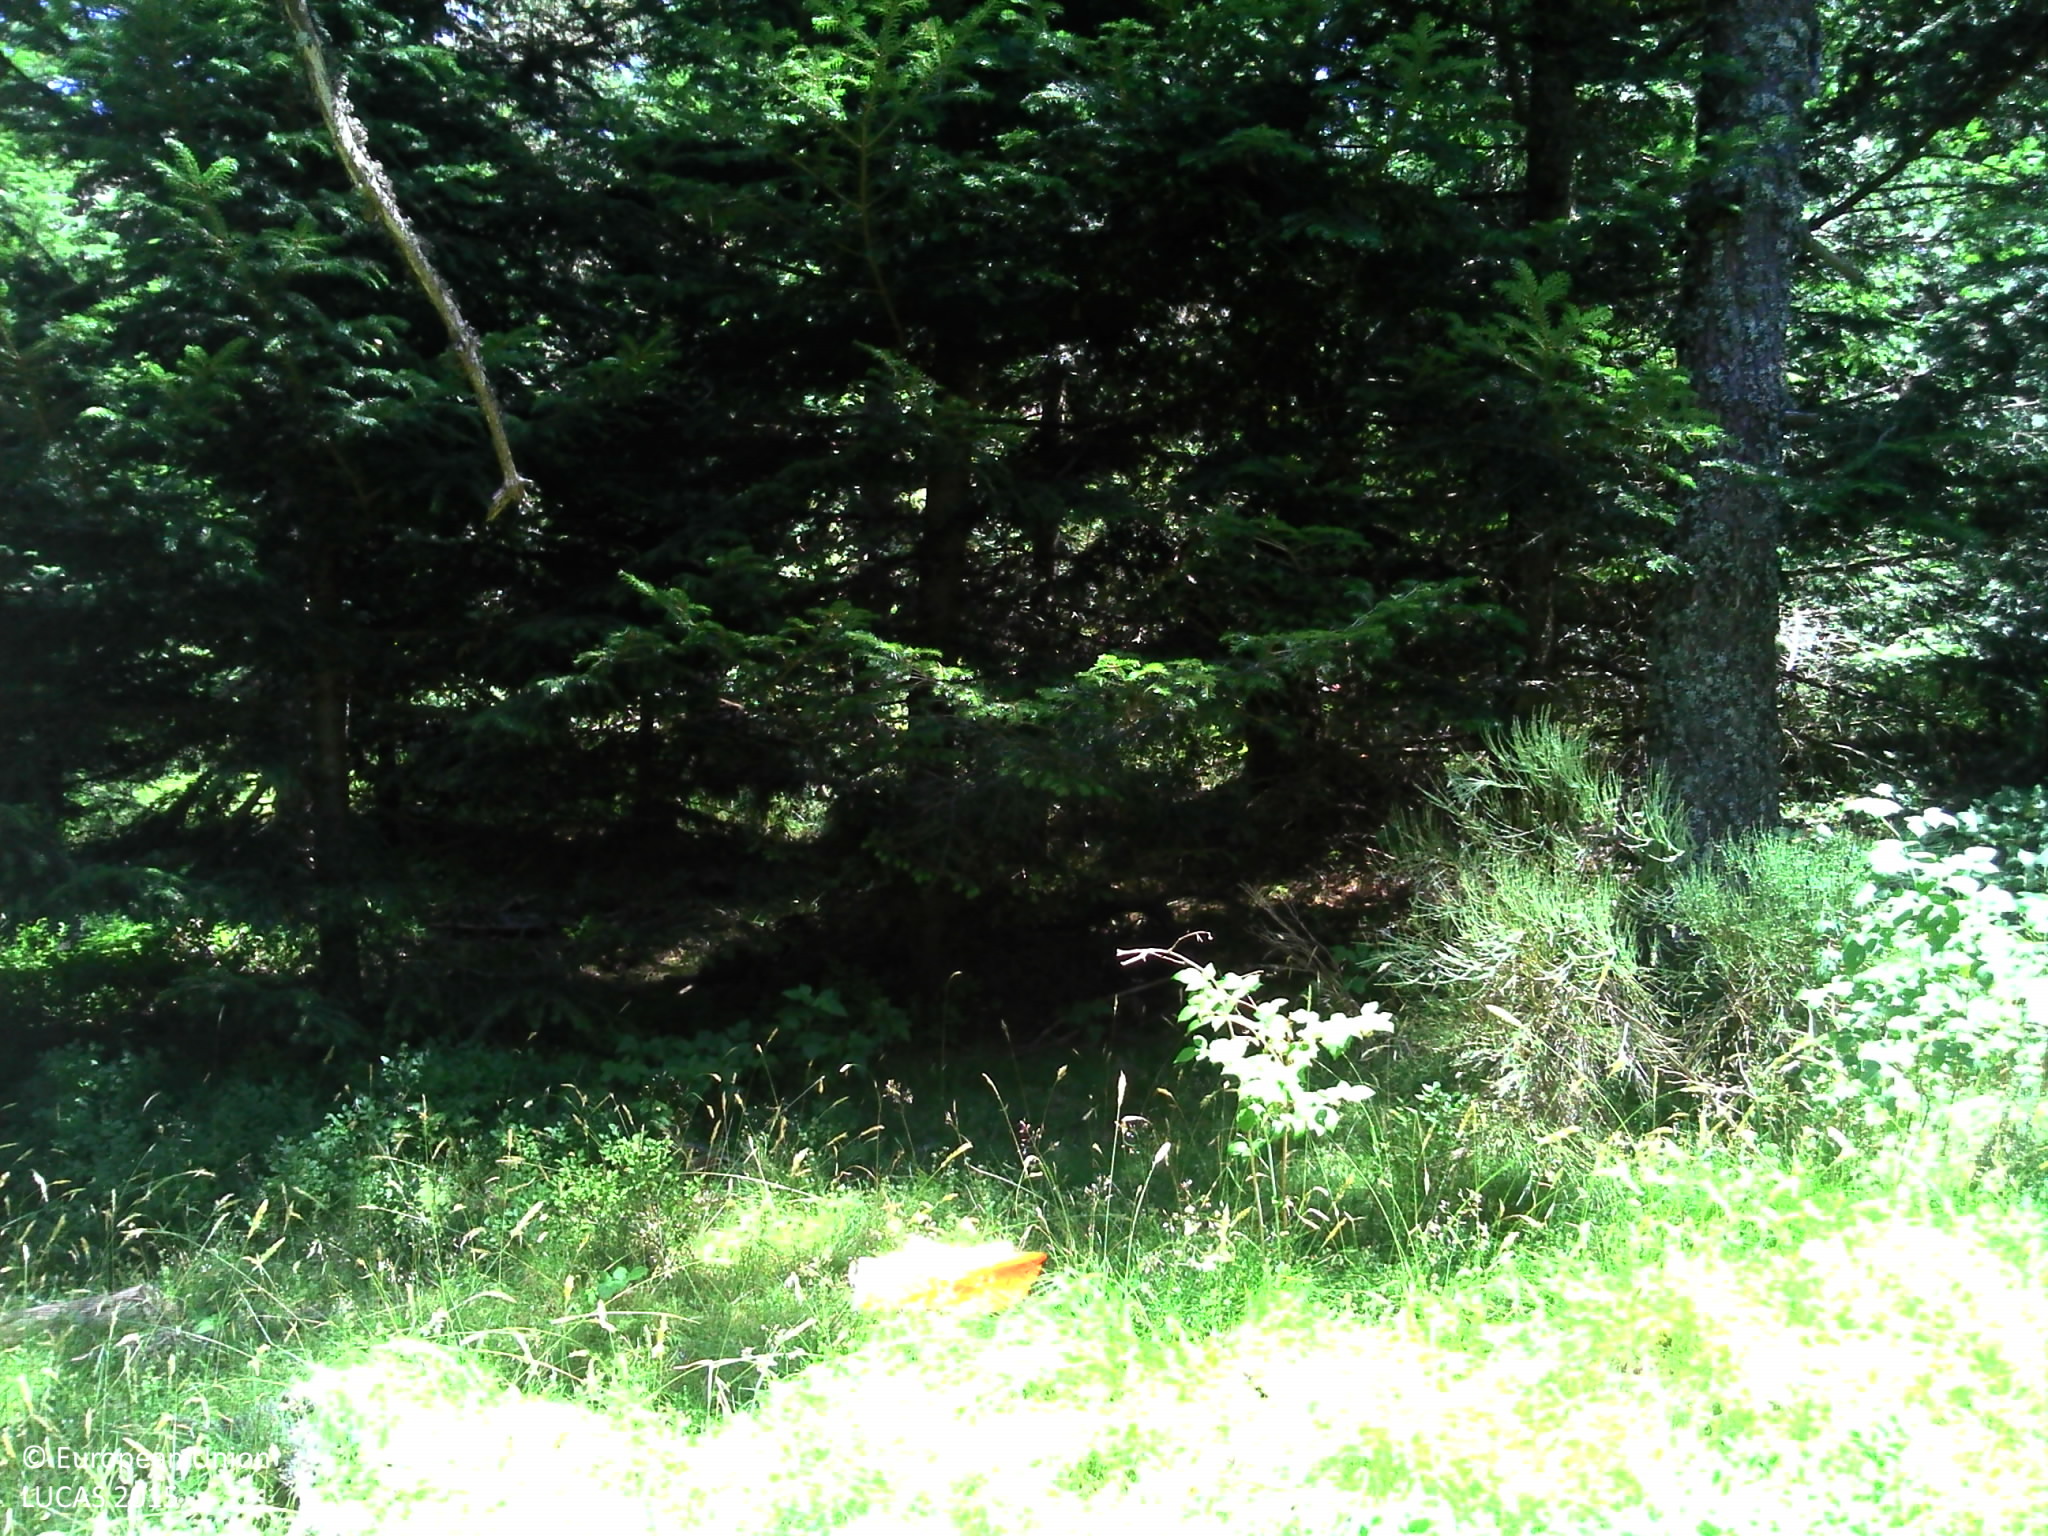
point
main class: Woodland
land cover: Spruce dominated coniferous woodland
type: exotic forest
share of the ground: > 75 %
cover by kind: coniferous forest trees 80 %, shrubs 10 %, herbaceous plants 10 %
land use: Forestry
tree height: > 5 m
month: July
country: FR
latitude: 44.9020
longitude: 3.4309
